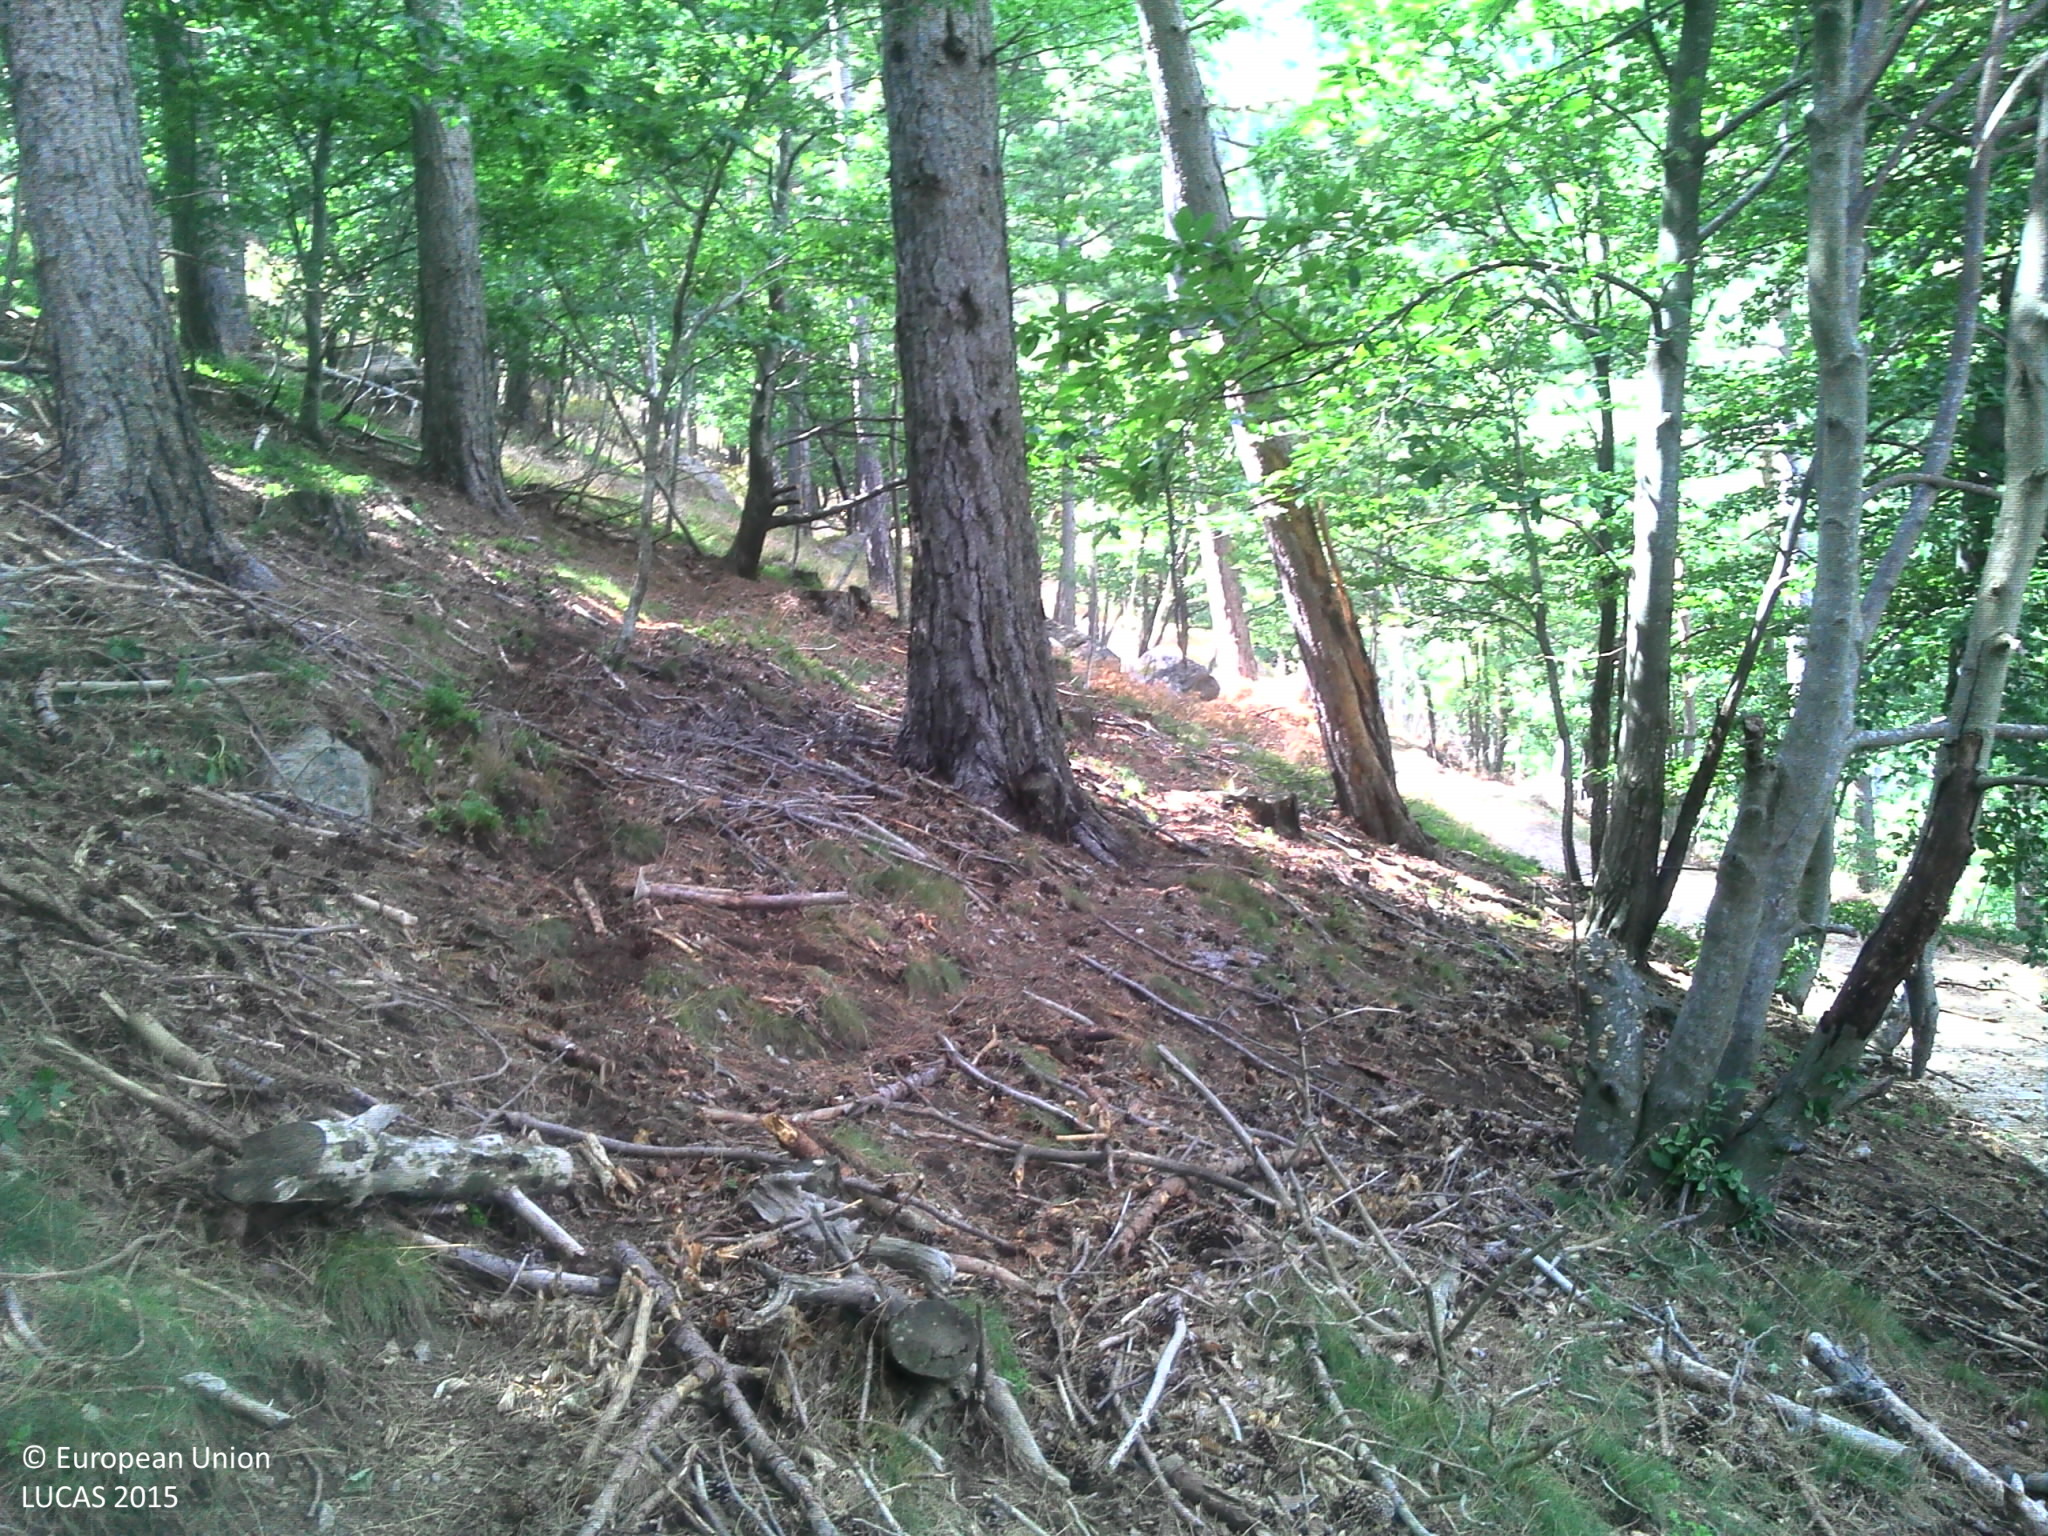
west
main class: Woodland
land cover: Spruce dominated mixed woodland
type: mountainous beech forest
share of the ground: > 75 %
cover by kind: coniferous forest trees 45 %, broadleaved forest trees 30 %, unconsolidated bare surface 15 %, herbaceous plants 10 %
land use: Forestry
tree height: > 5 m
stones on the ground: 10 - 25 %
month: August
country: FR
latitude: 44.7353
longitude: 4.2853
